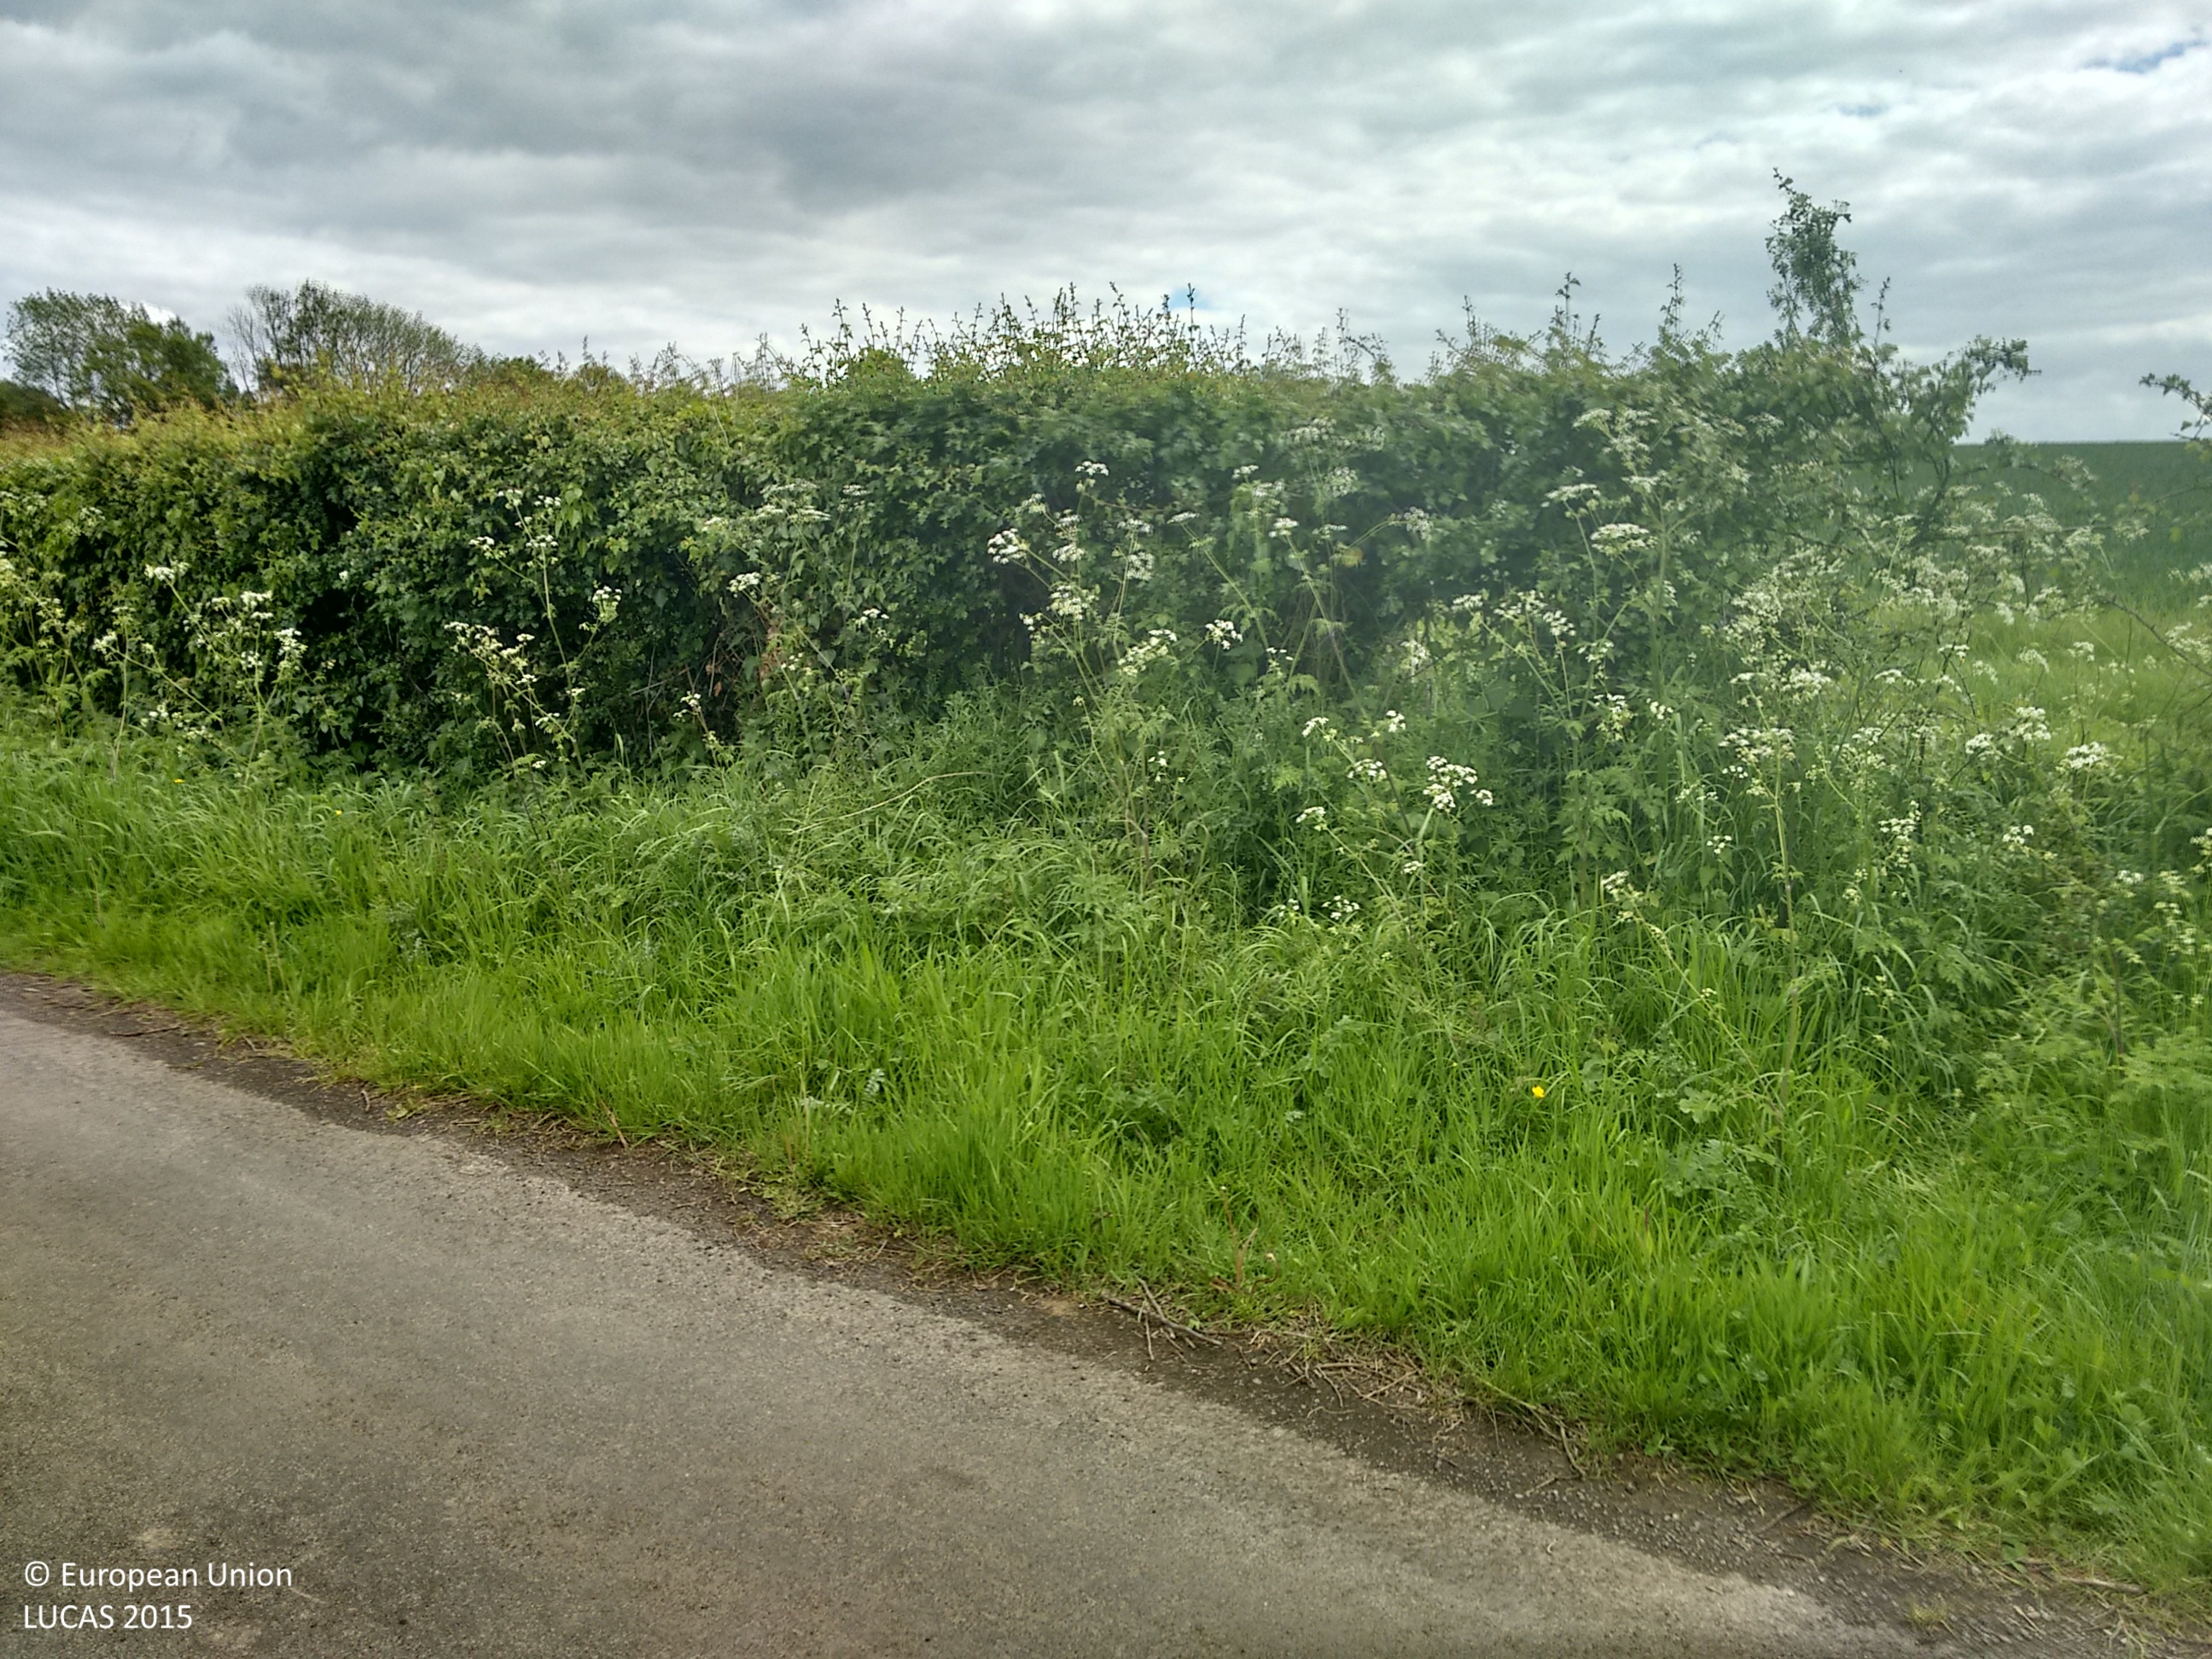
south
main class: Cropland
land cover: Dry pulses
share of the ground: 50 - 75 %
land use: Agriculture (excluding fallow land and kitchen gardens)
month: May
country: GB
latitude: 51.1514
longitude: 0.1470
